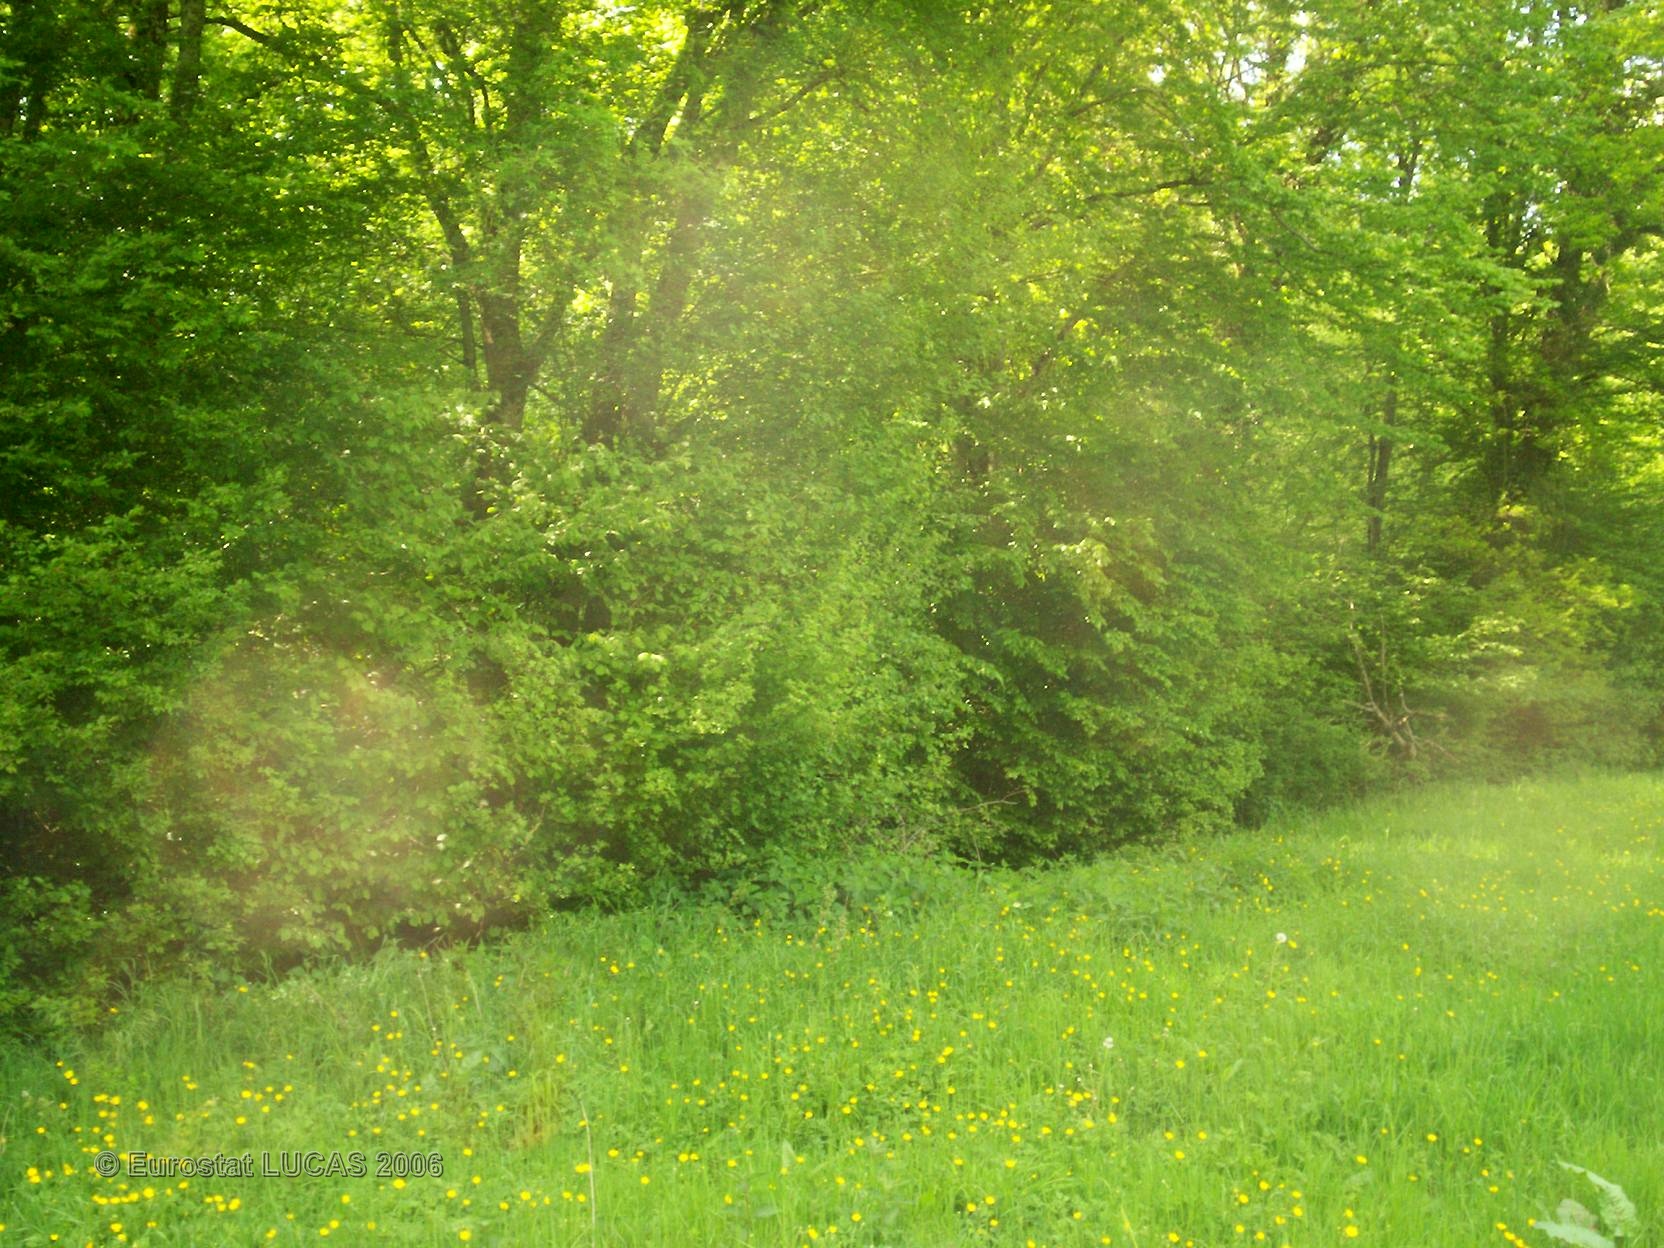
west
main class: Grassland
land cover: Grassland without tree/shrub cover
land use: Agriculture (excluding fallow land and kitchen gardens)
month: May
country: FR
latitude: 48.3380
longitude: 4.8583
